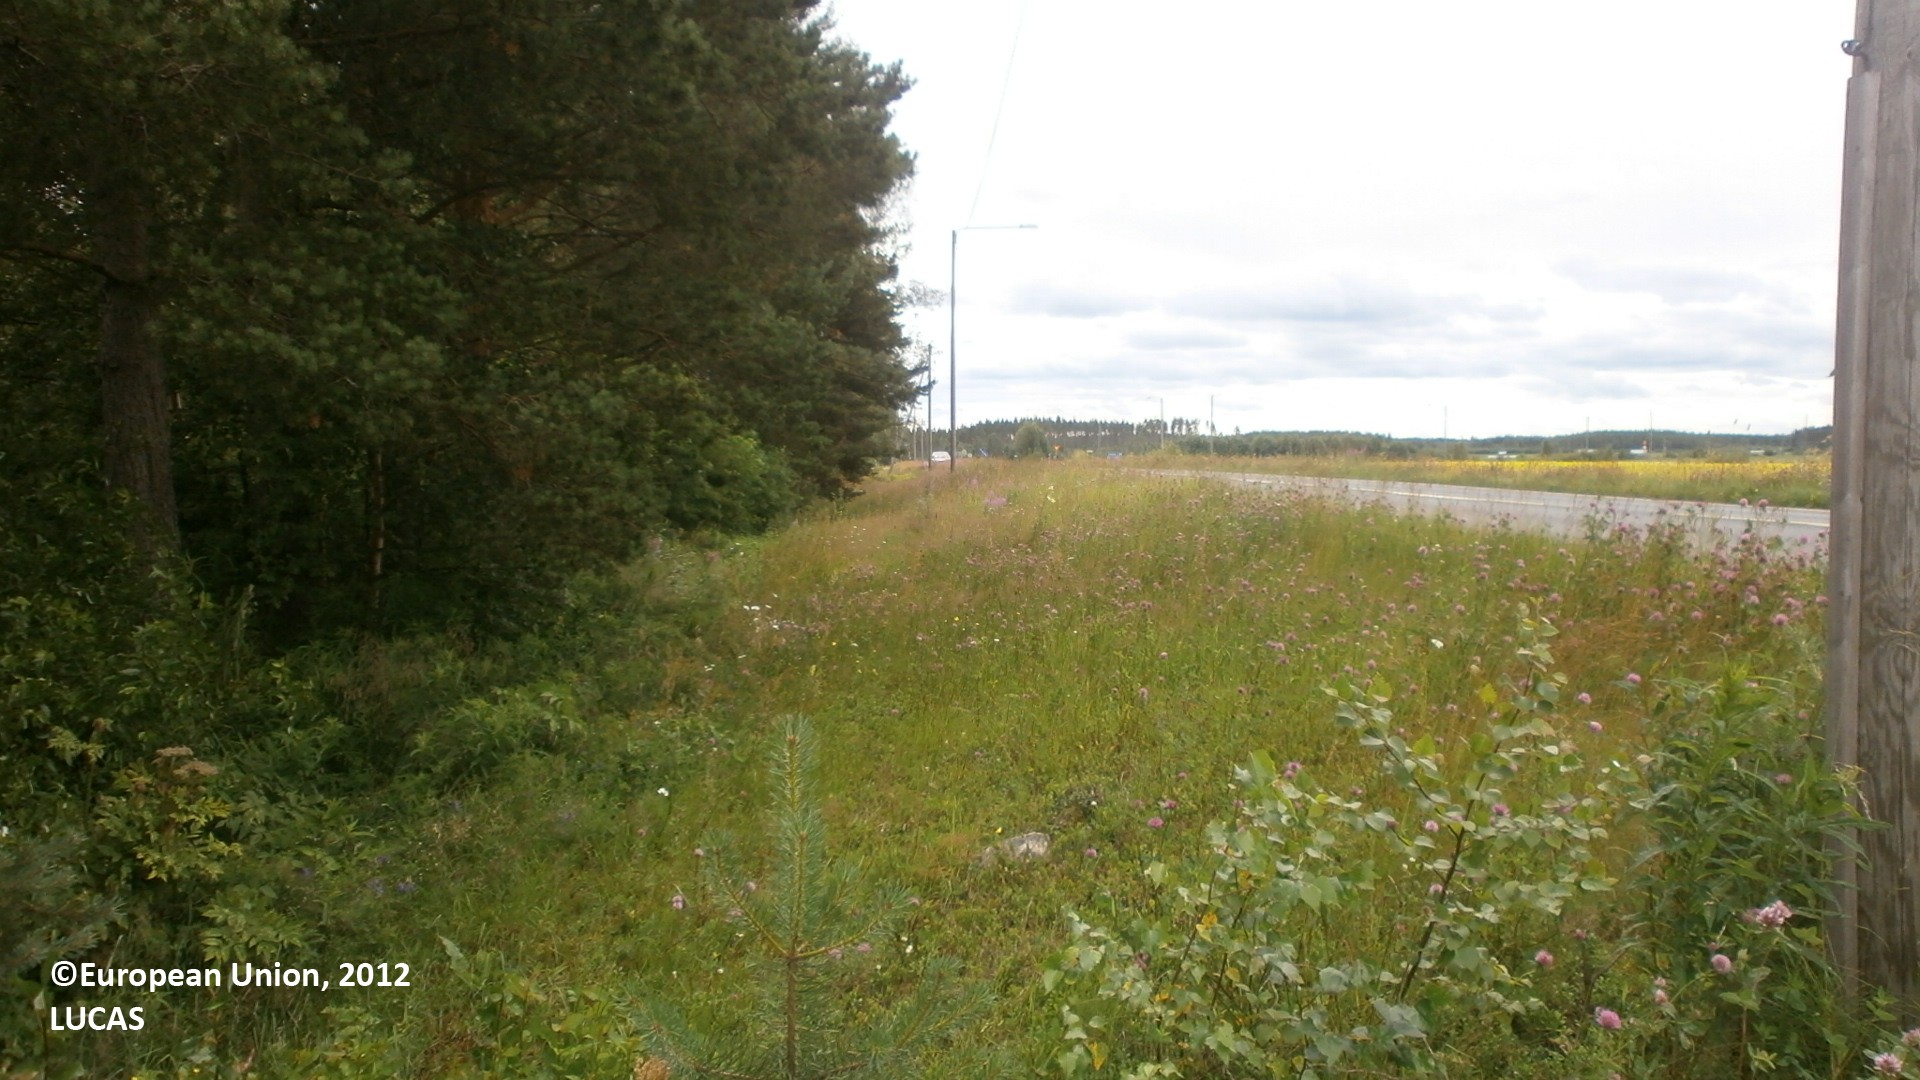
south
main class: Grassland
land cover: Spontaneously vegetated surfaces
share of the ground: > 75 %
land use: Road transport
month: July
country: FI
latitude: 63.9878
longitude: 24.2742
